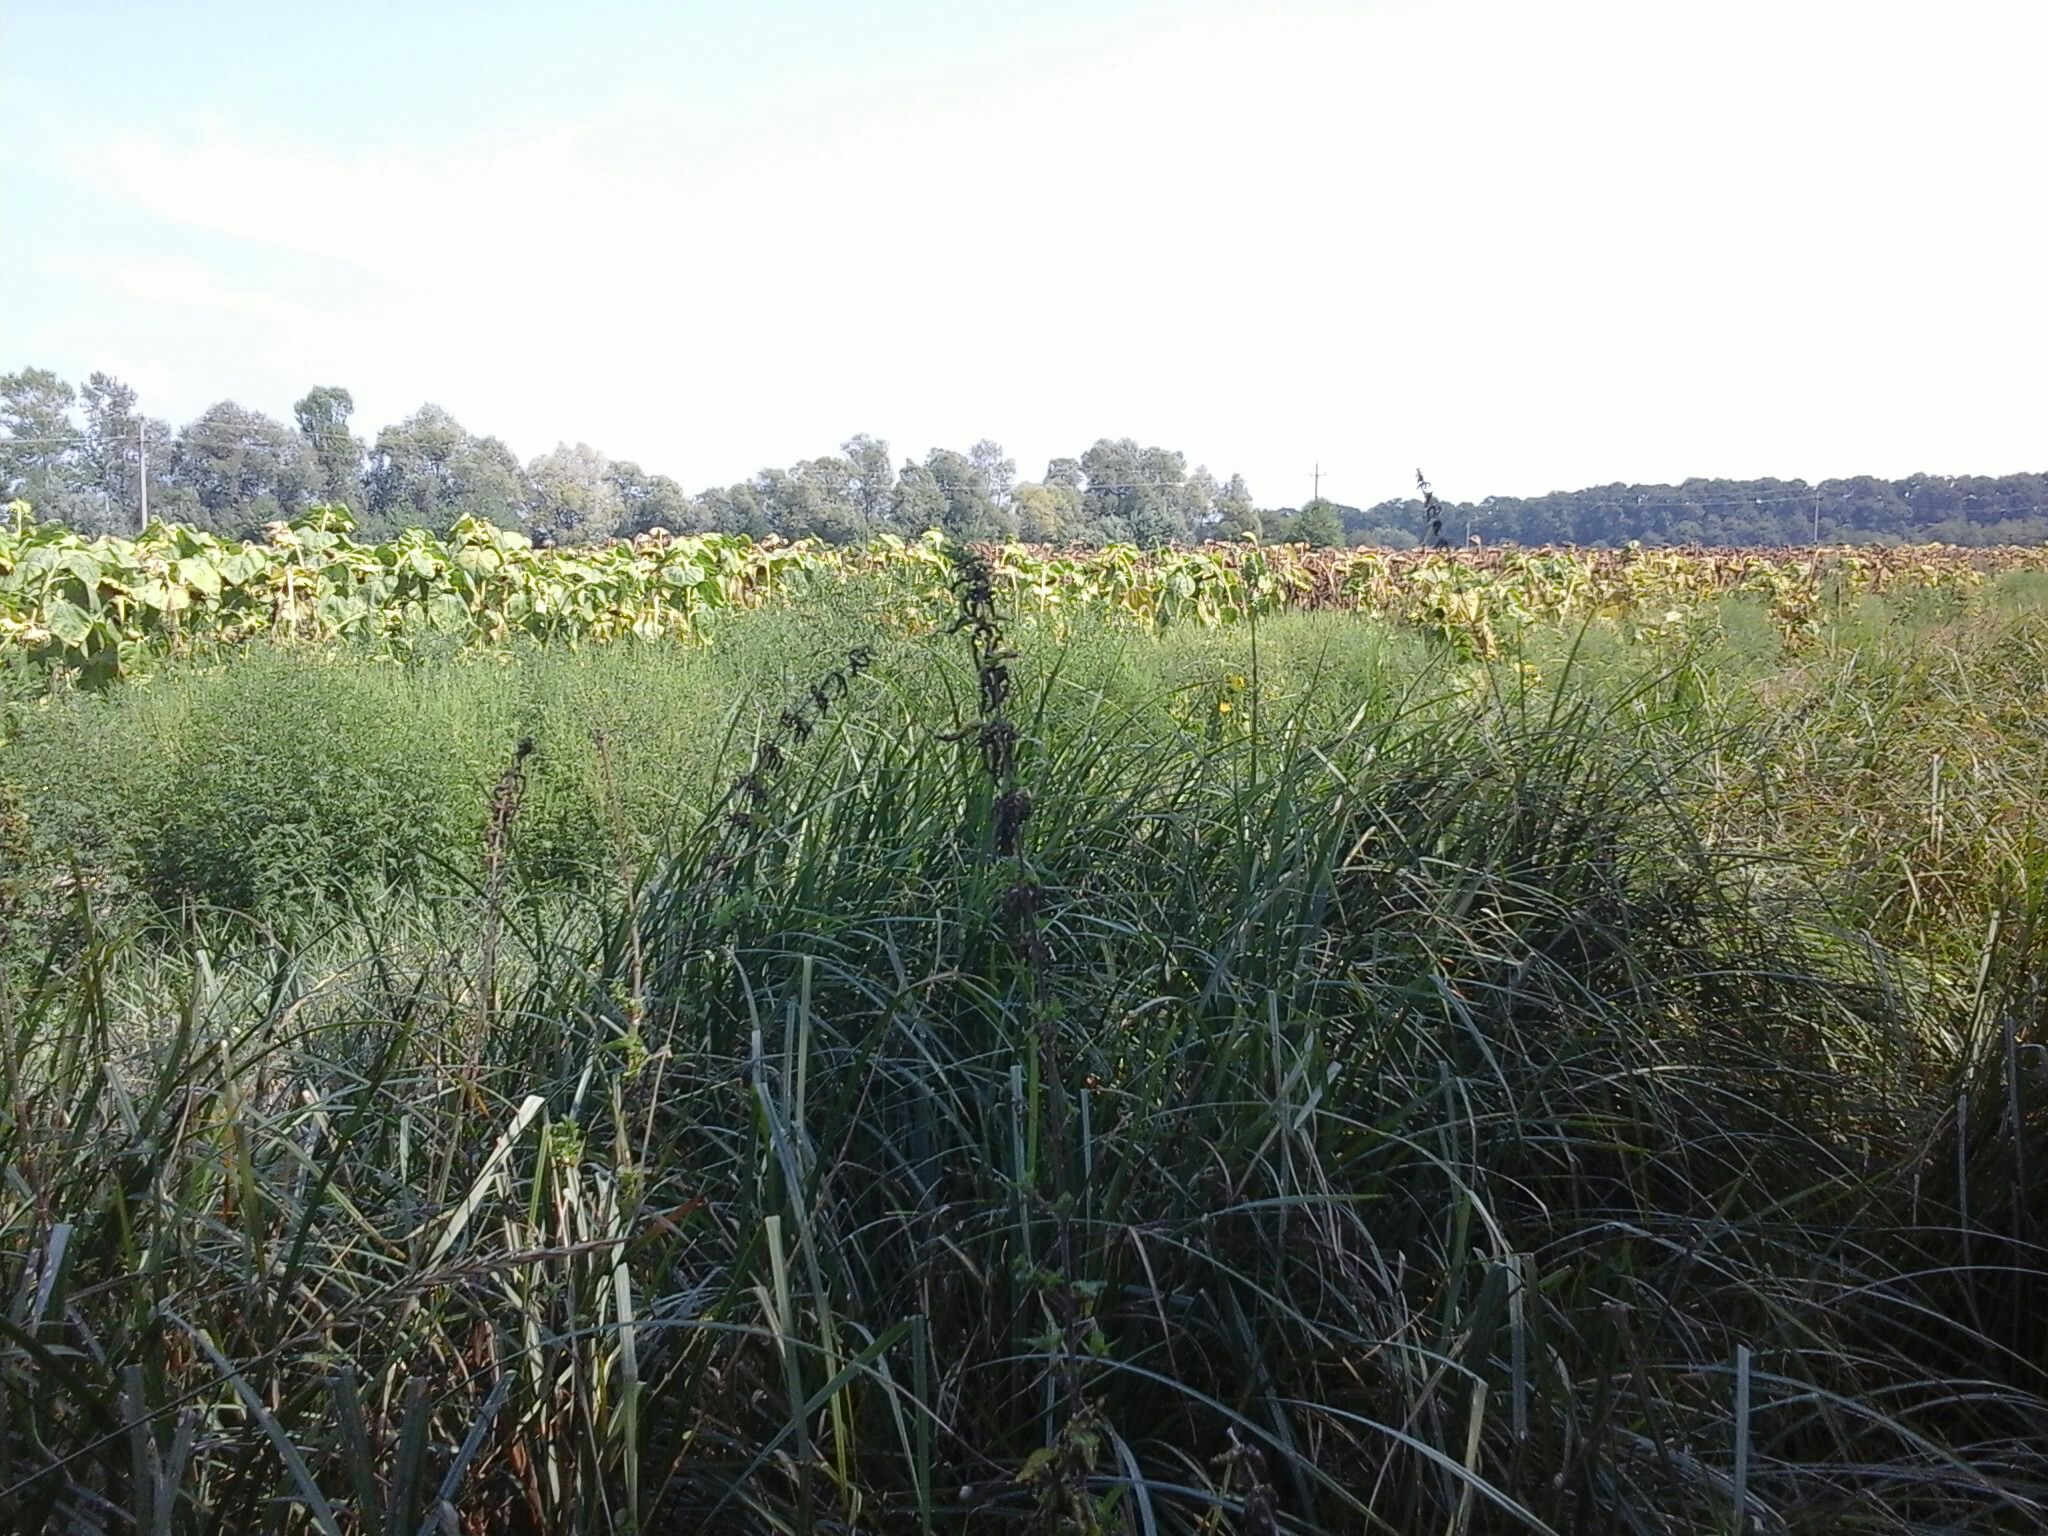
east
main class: Grassland
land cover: Grassland with sparse tree/shrub cover
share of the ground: > 75 %
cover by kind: herbaceous plants 95 %, broadleaved forest trees 5 %
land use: Semi-natural and natural areas not in use
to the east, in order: Grassland with sparse tree/shrub cover; Sunflower; Electric lines; Sunflower
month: August
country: HU
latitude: 48.0389
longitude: 19.1816
